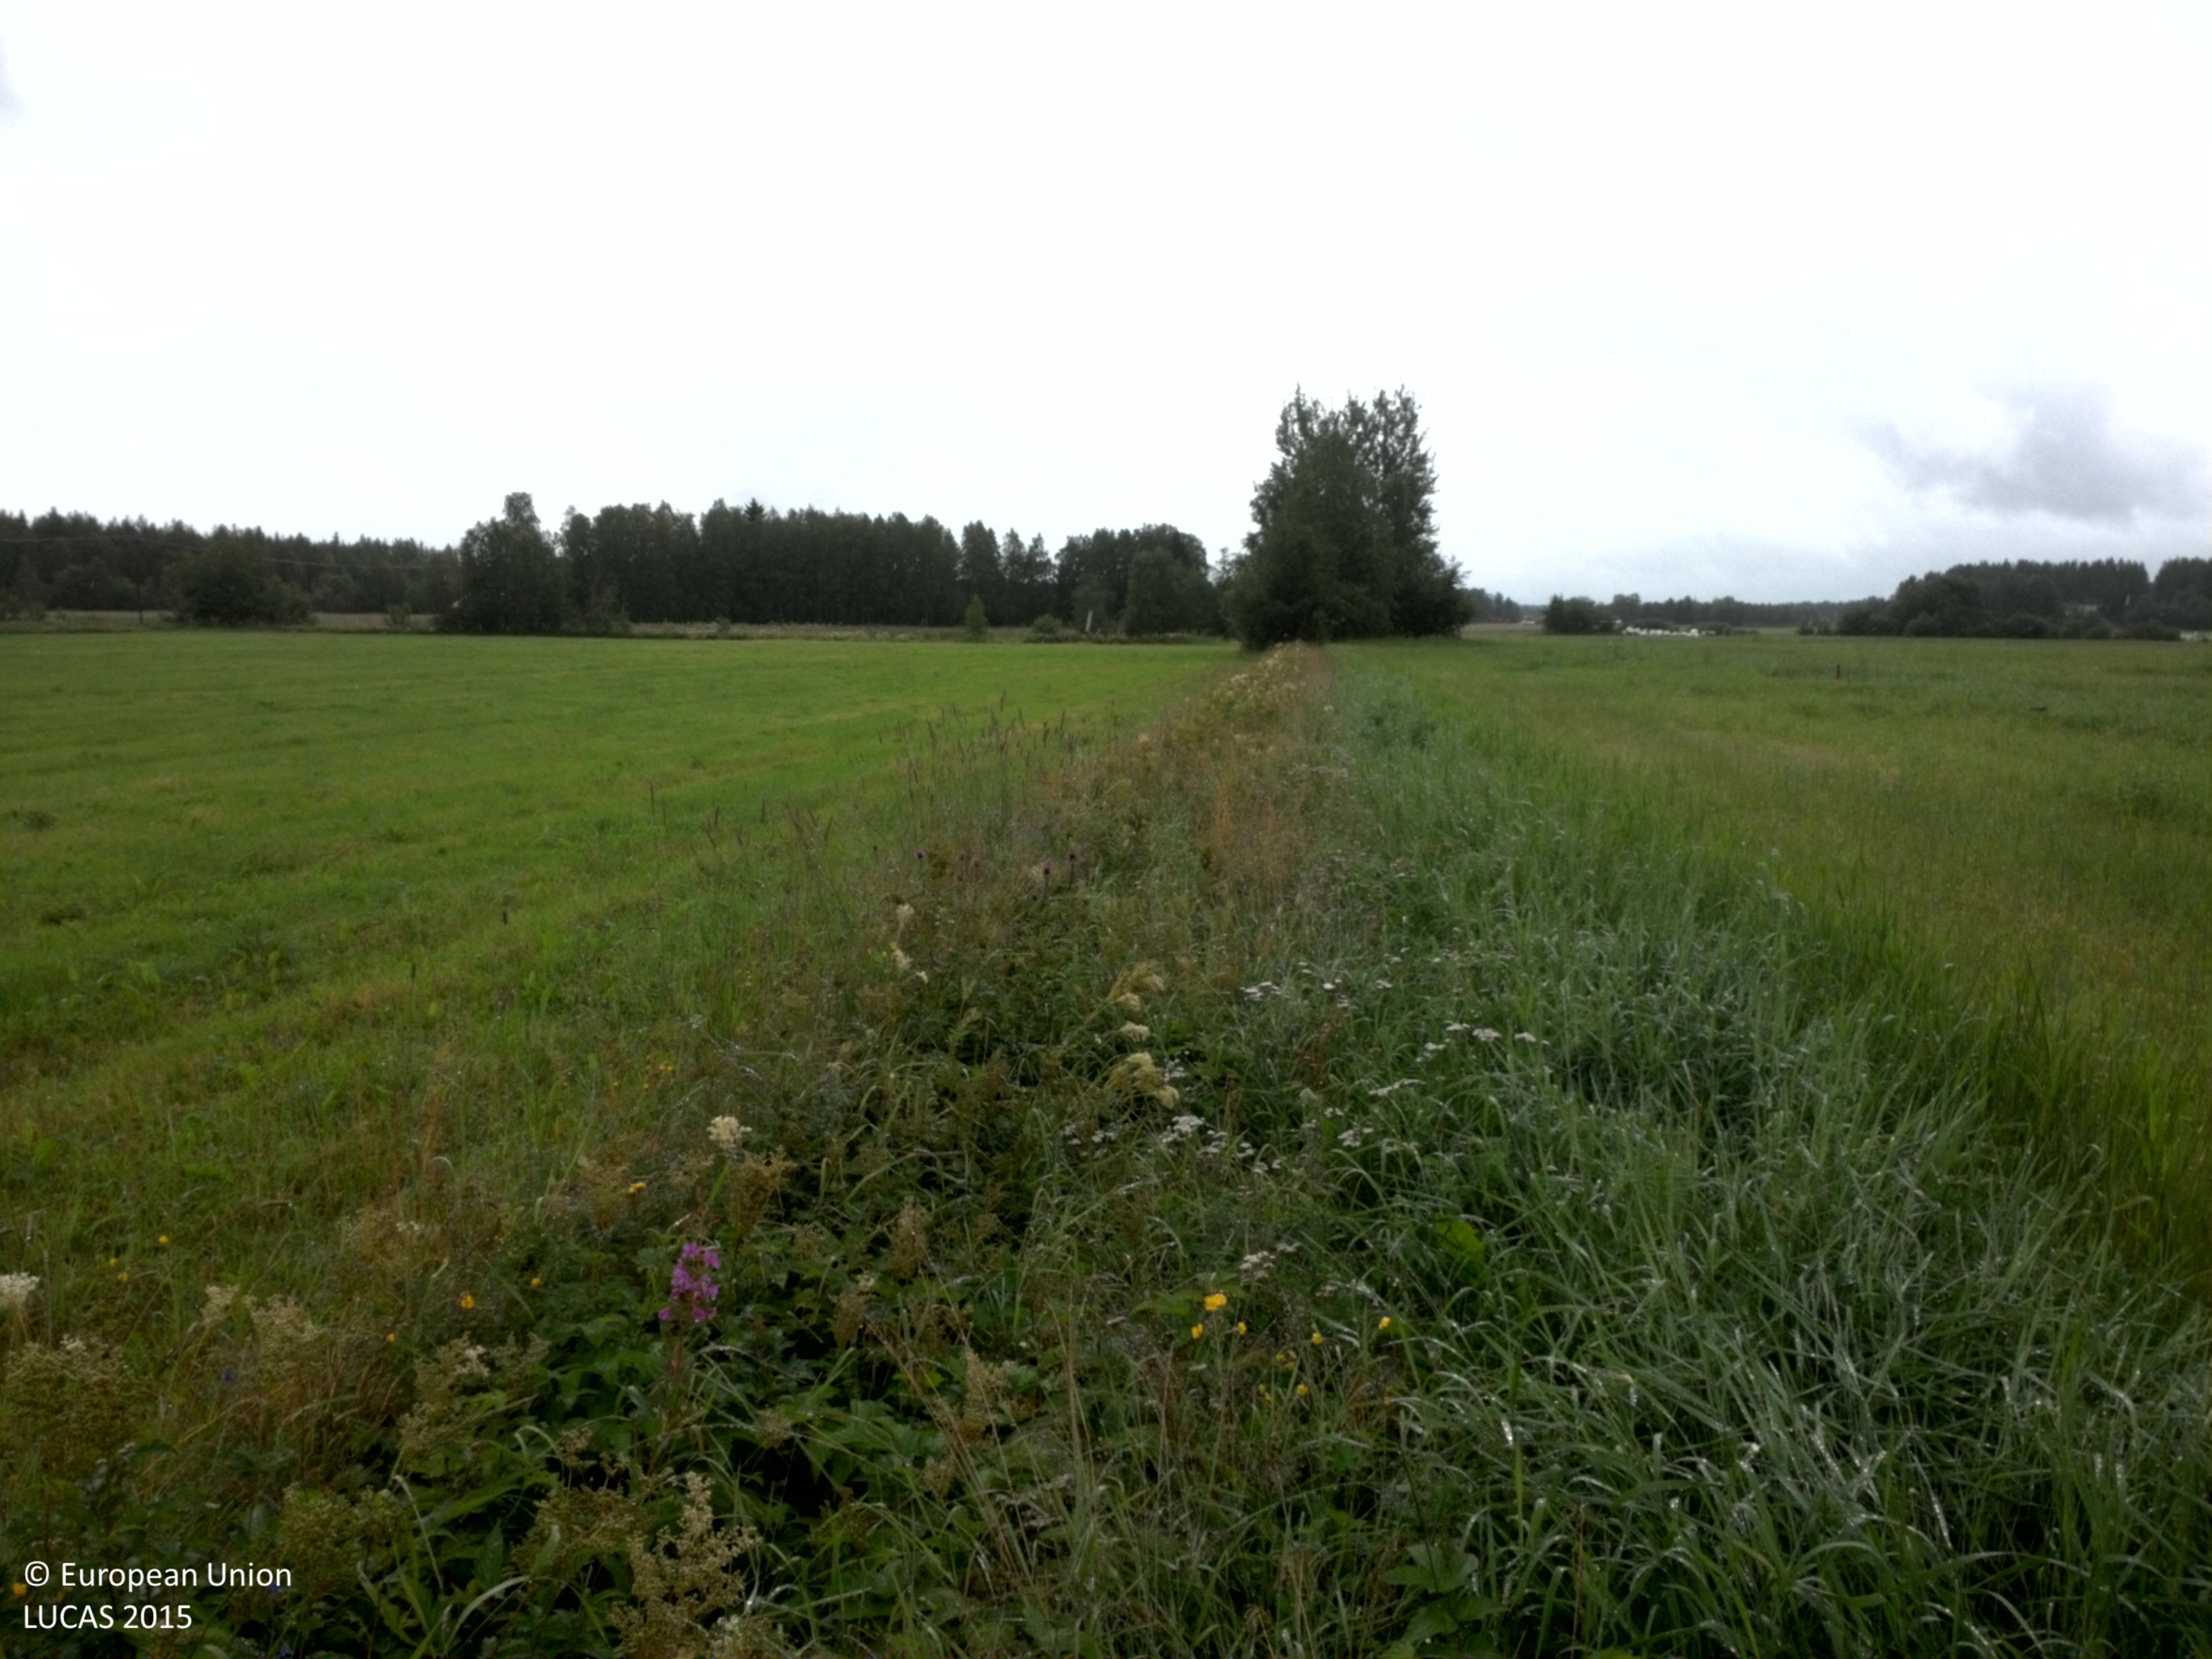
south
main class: Cropland
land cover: Barley
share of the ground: > 75 %
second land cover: Rye
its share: 25 - 50 %
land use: Agriculture (excluding fallow land and kitchen gardens)
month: August
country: SE
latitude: 64.6563
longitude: 20.9716
